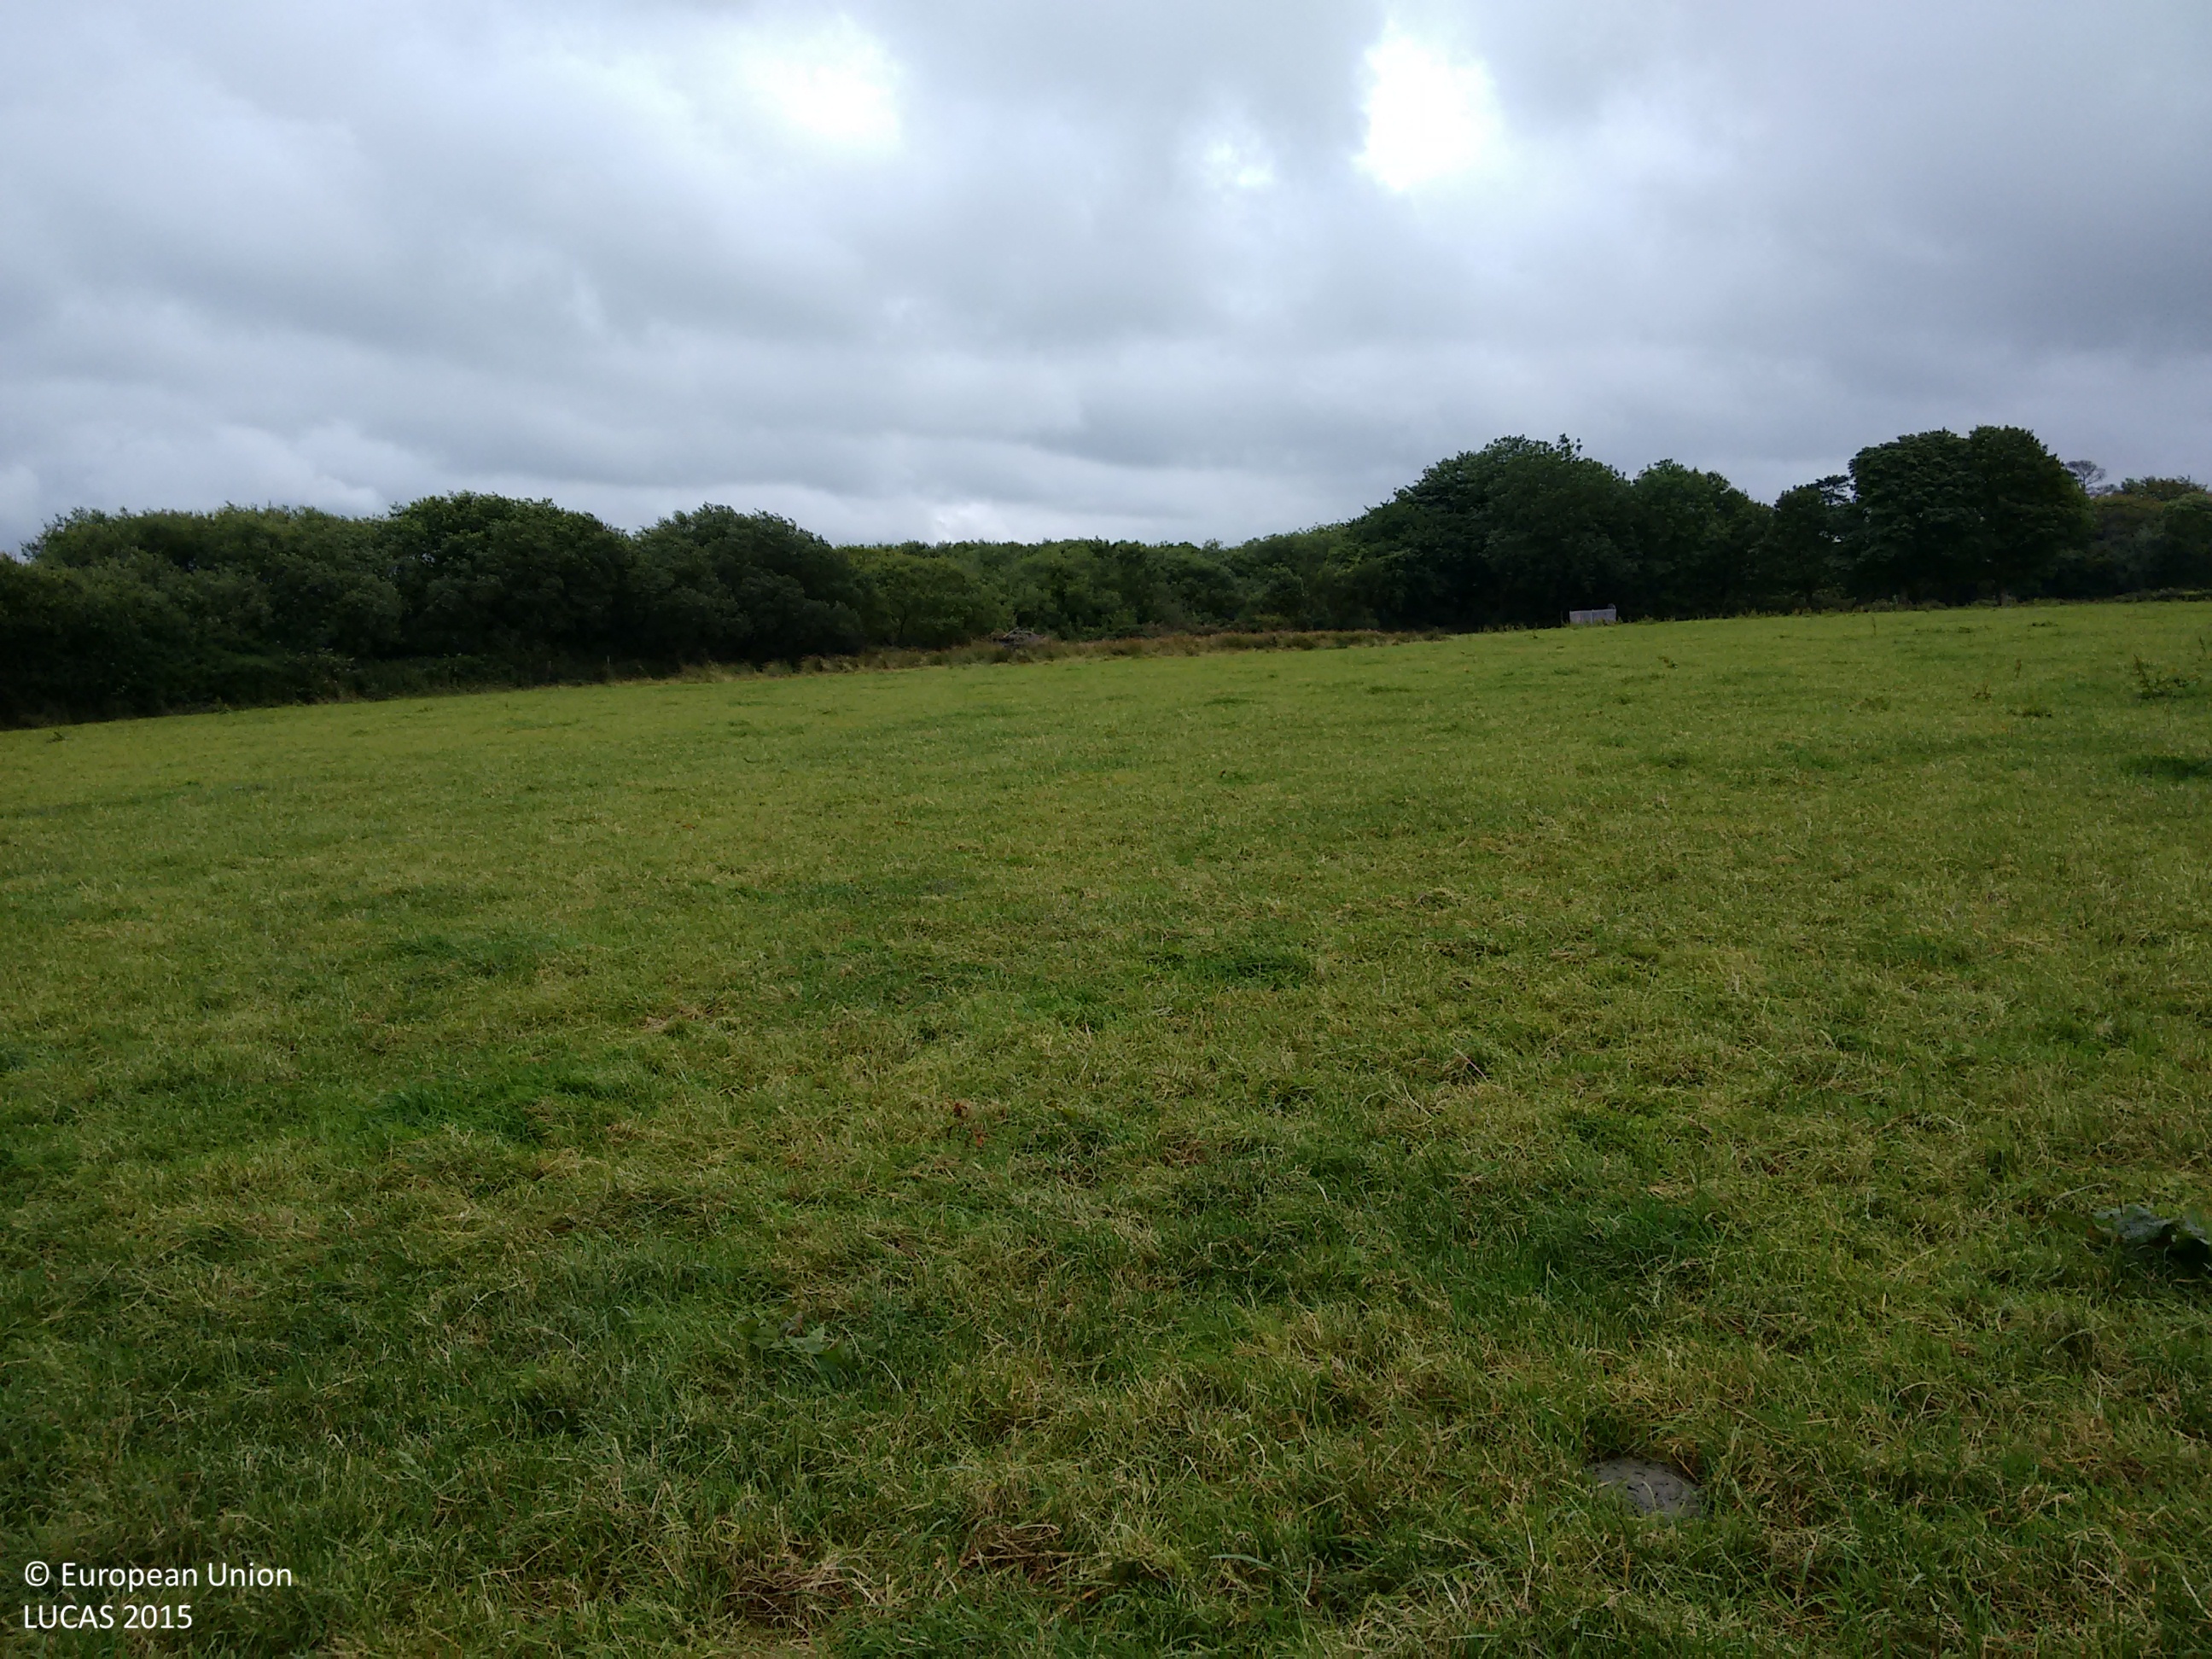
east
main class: Grassland
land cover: Grassland without tree/shrub cover
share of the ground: > 75 %
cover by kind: herbaceous plants 100 %
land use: Agriculture (excluding fallow land and kitchen gardens)
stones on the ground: < 10 %
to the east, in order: Grassland without tree/shrub cover; Fences; Broadleaved woodland; Fences; Single bushes/trees; Grassland with sparse tree/shrub cover; Broadleaved woodland; Grassland without tree/shrub cover
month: August
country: GB
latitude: 51.9388
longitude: -4.4912
